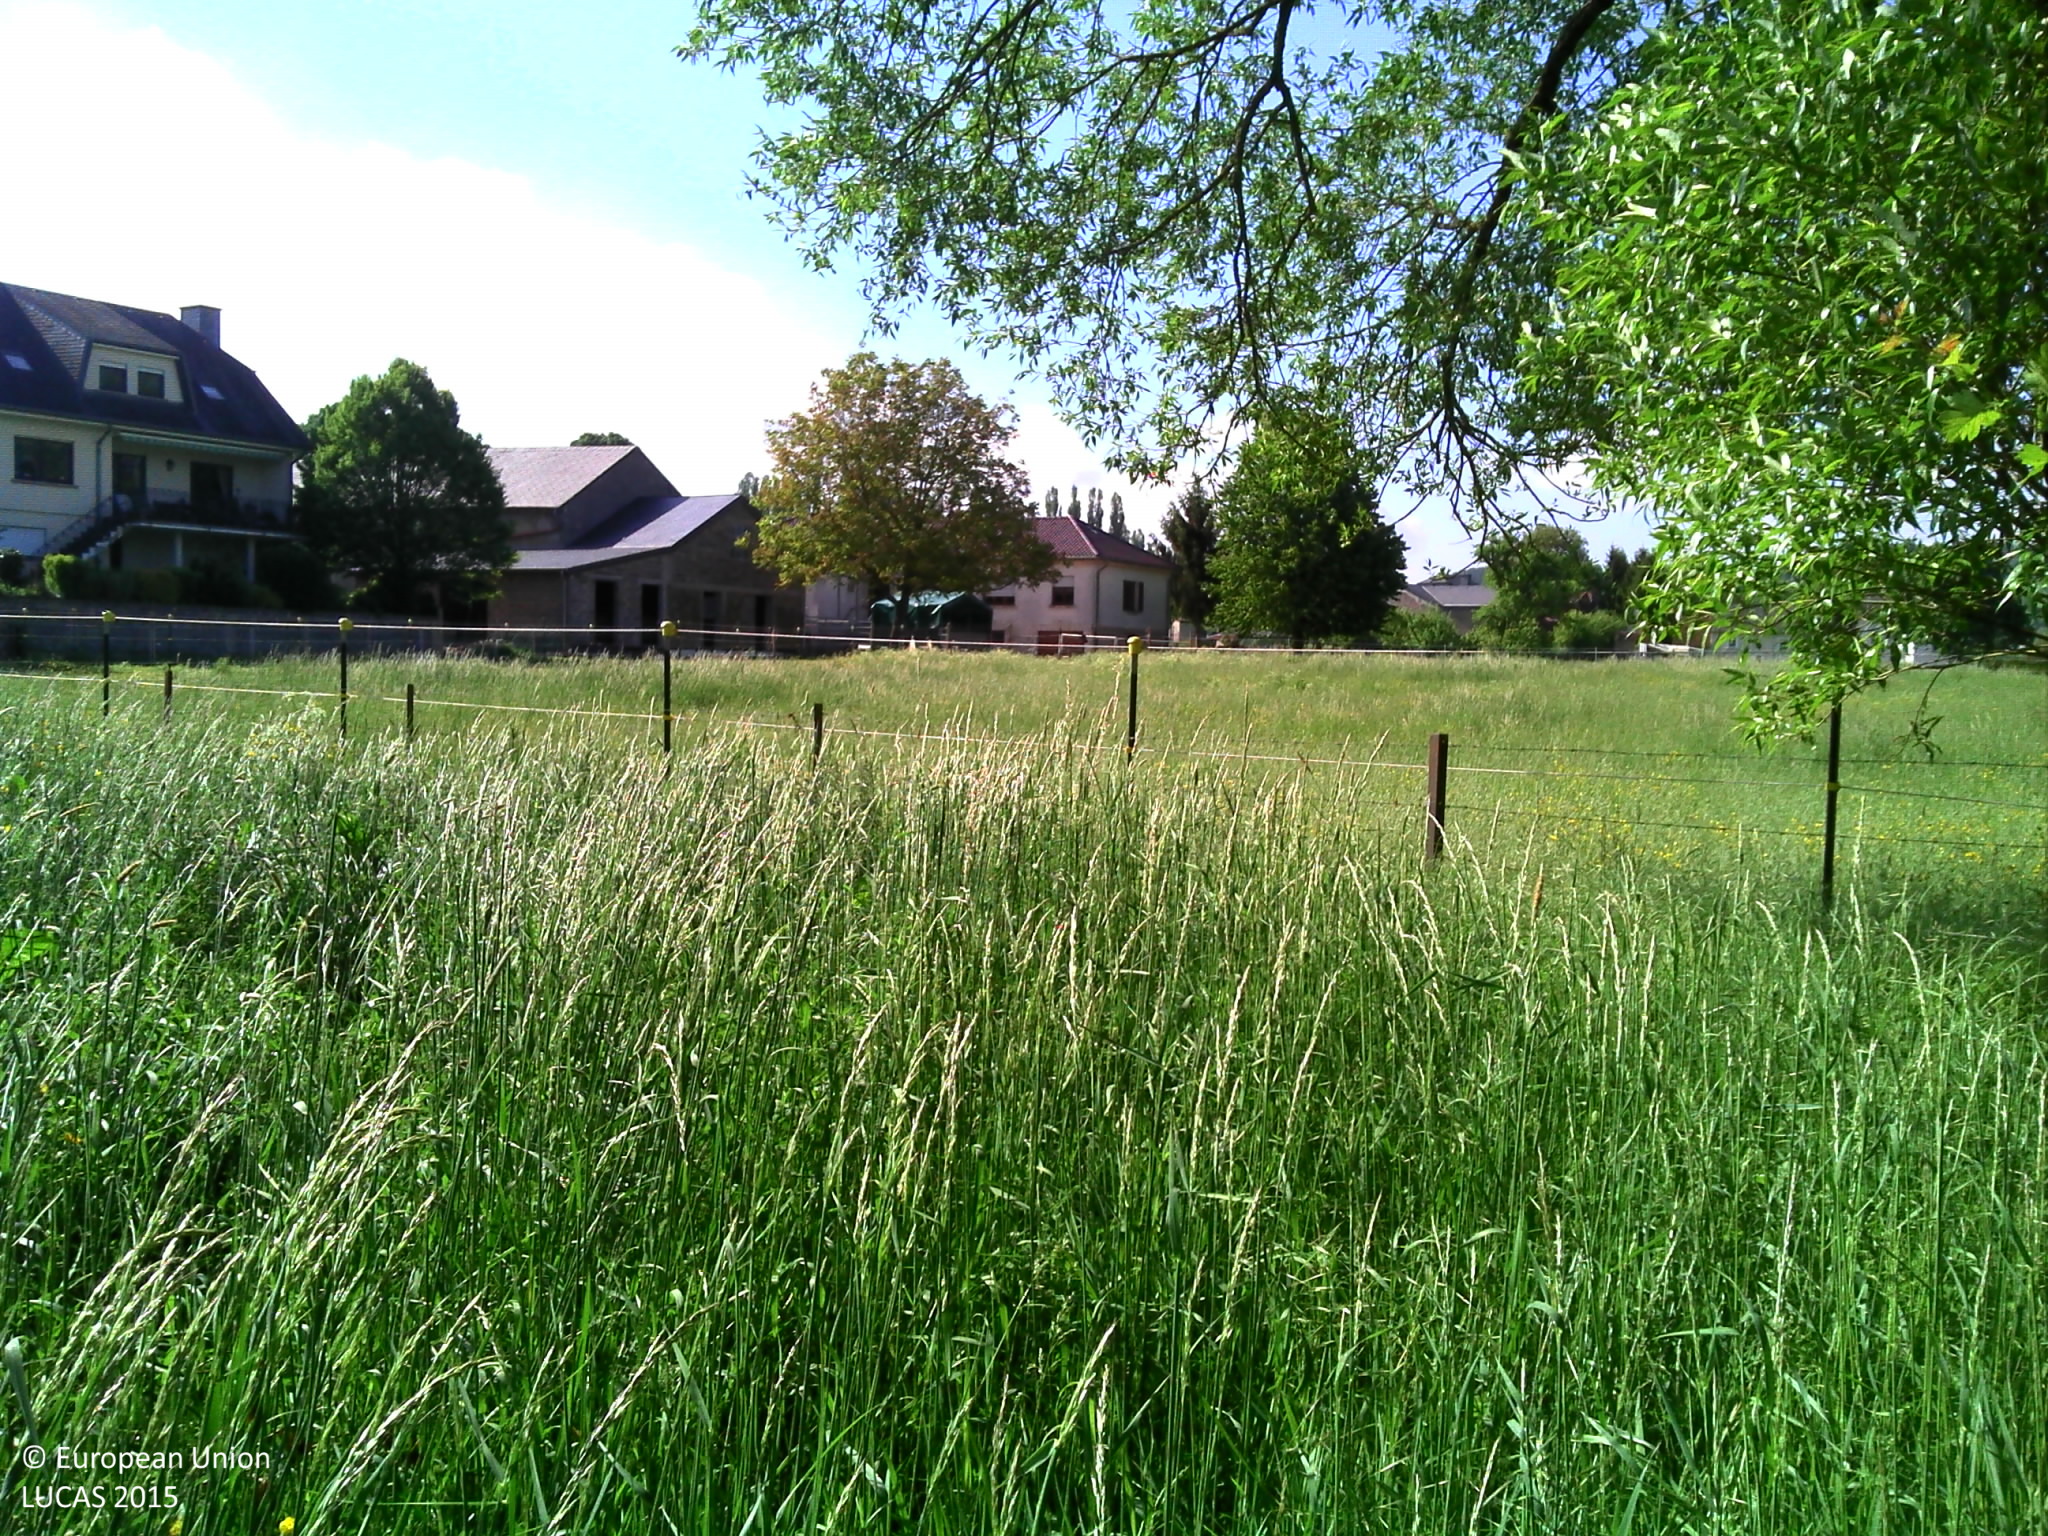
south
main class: Woodland
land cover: Broadleaved woodland
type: floodplain forest
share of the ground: > 75 %
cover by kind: broadleaved forest trees 80 %, herbaceous plants 15 %, shrubs 5 %
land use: Agriculture (excluding fallow land and kitchen gardens)
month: May
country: LU
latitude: 49.6562
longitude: 6.3010
